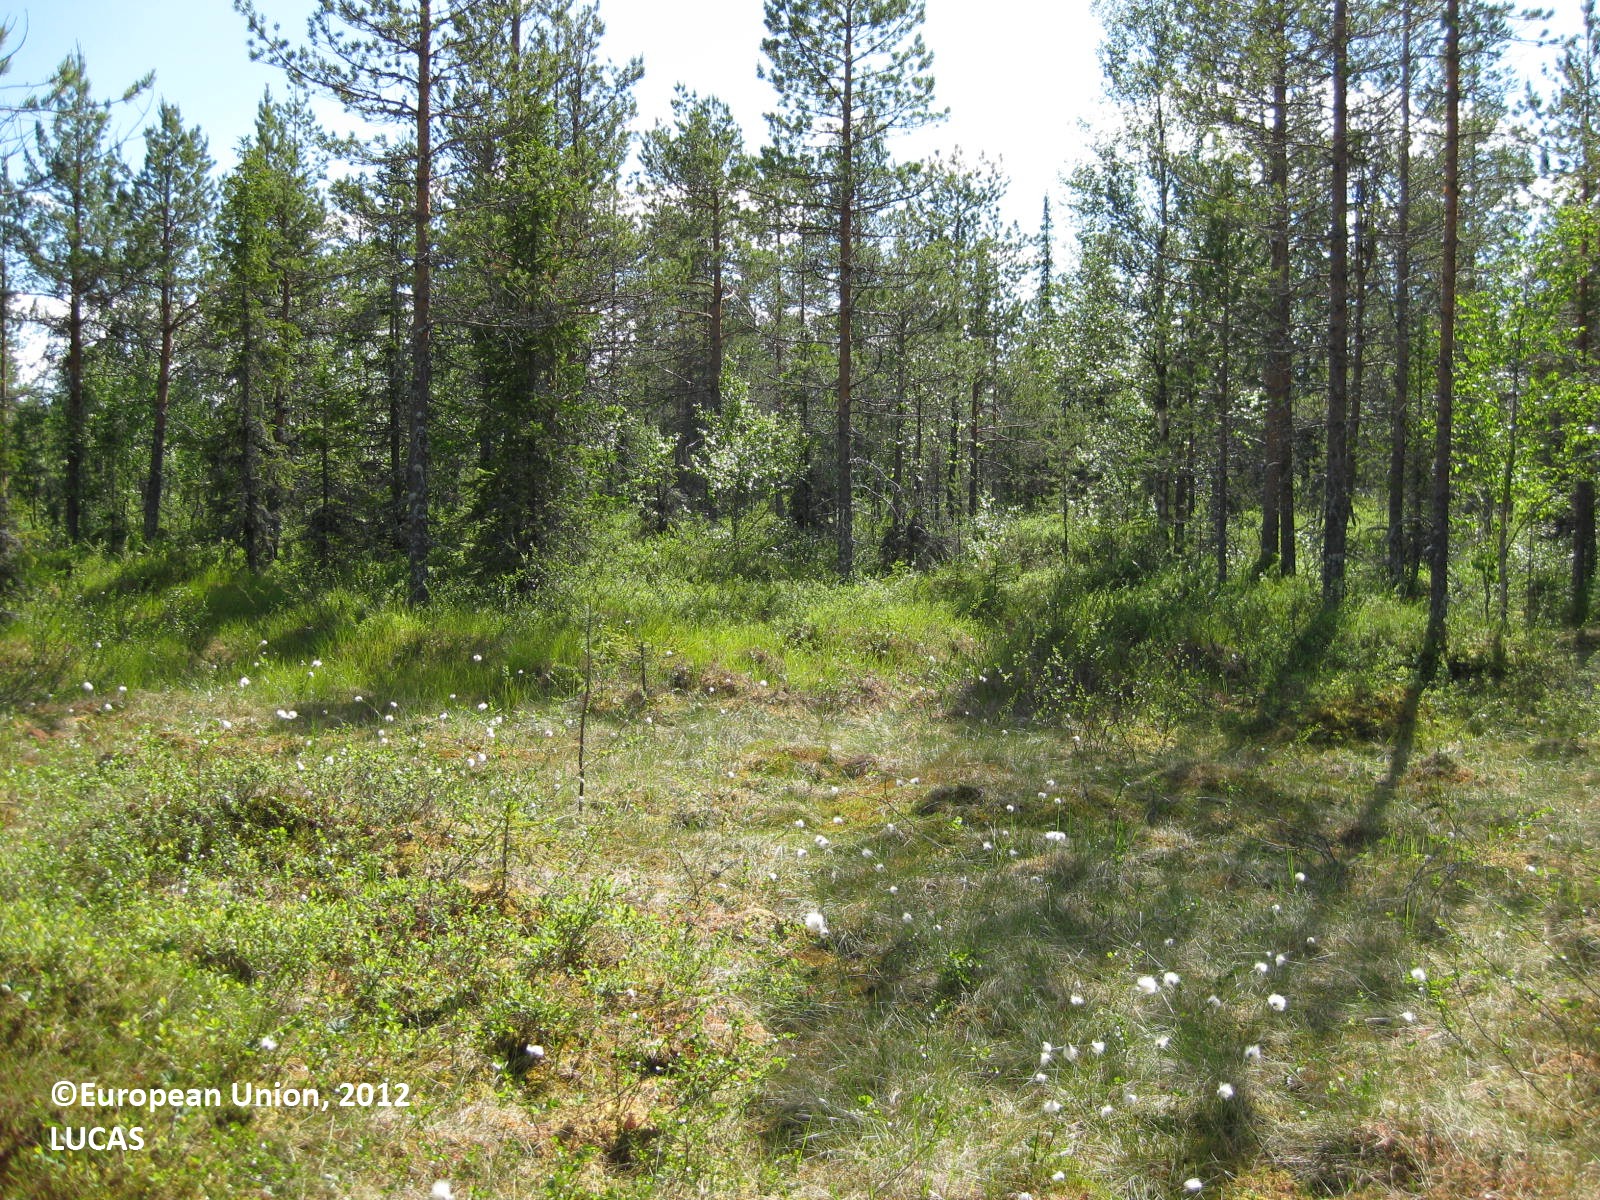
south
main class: Woodland
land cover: Pine dominated coniferous woodland
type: boreal forest
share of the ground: 50 - 75 %
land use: Forestry
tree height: > 5 m
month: July
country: FI
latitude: 65.6085
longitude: 29.4886
